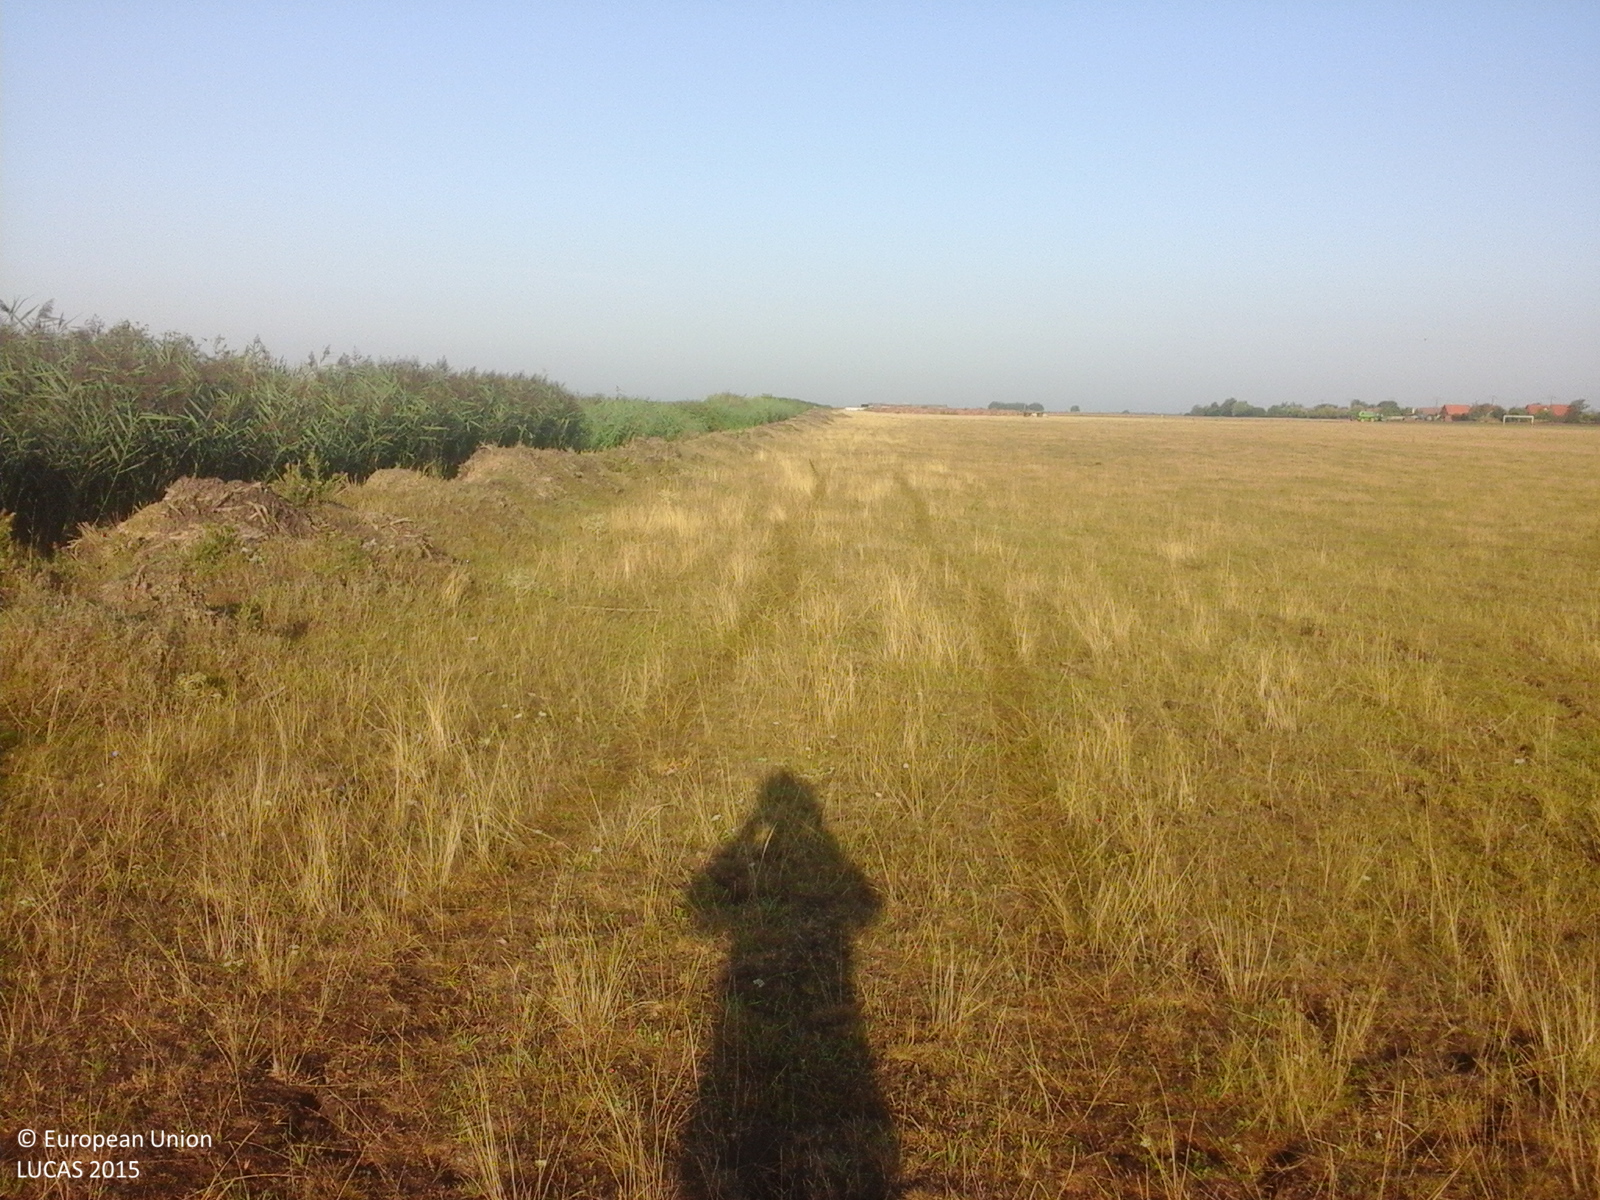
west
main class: Grassland
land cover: Grassland without tree/shrub cover
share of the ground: > 75 %
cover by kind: herbaceous plants 100 %
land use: Agriculture (excluding fallow land and kitchen gardens)
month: August
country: RO
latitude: 45.7056
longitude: 21.0359
